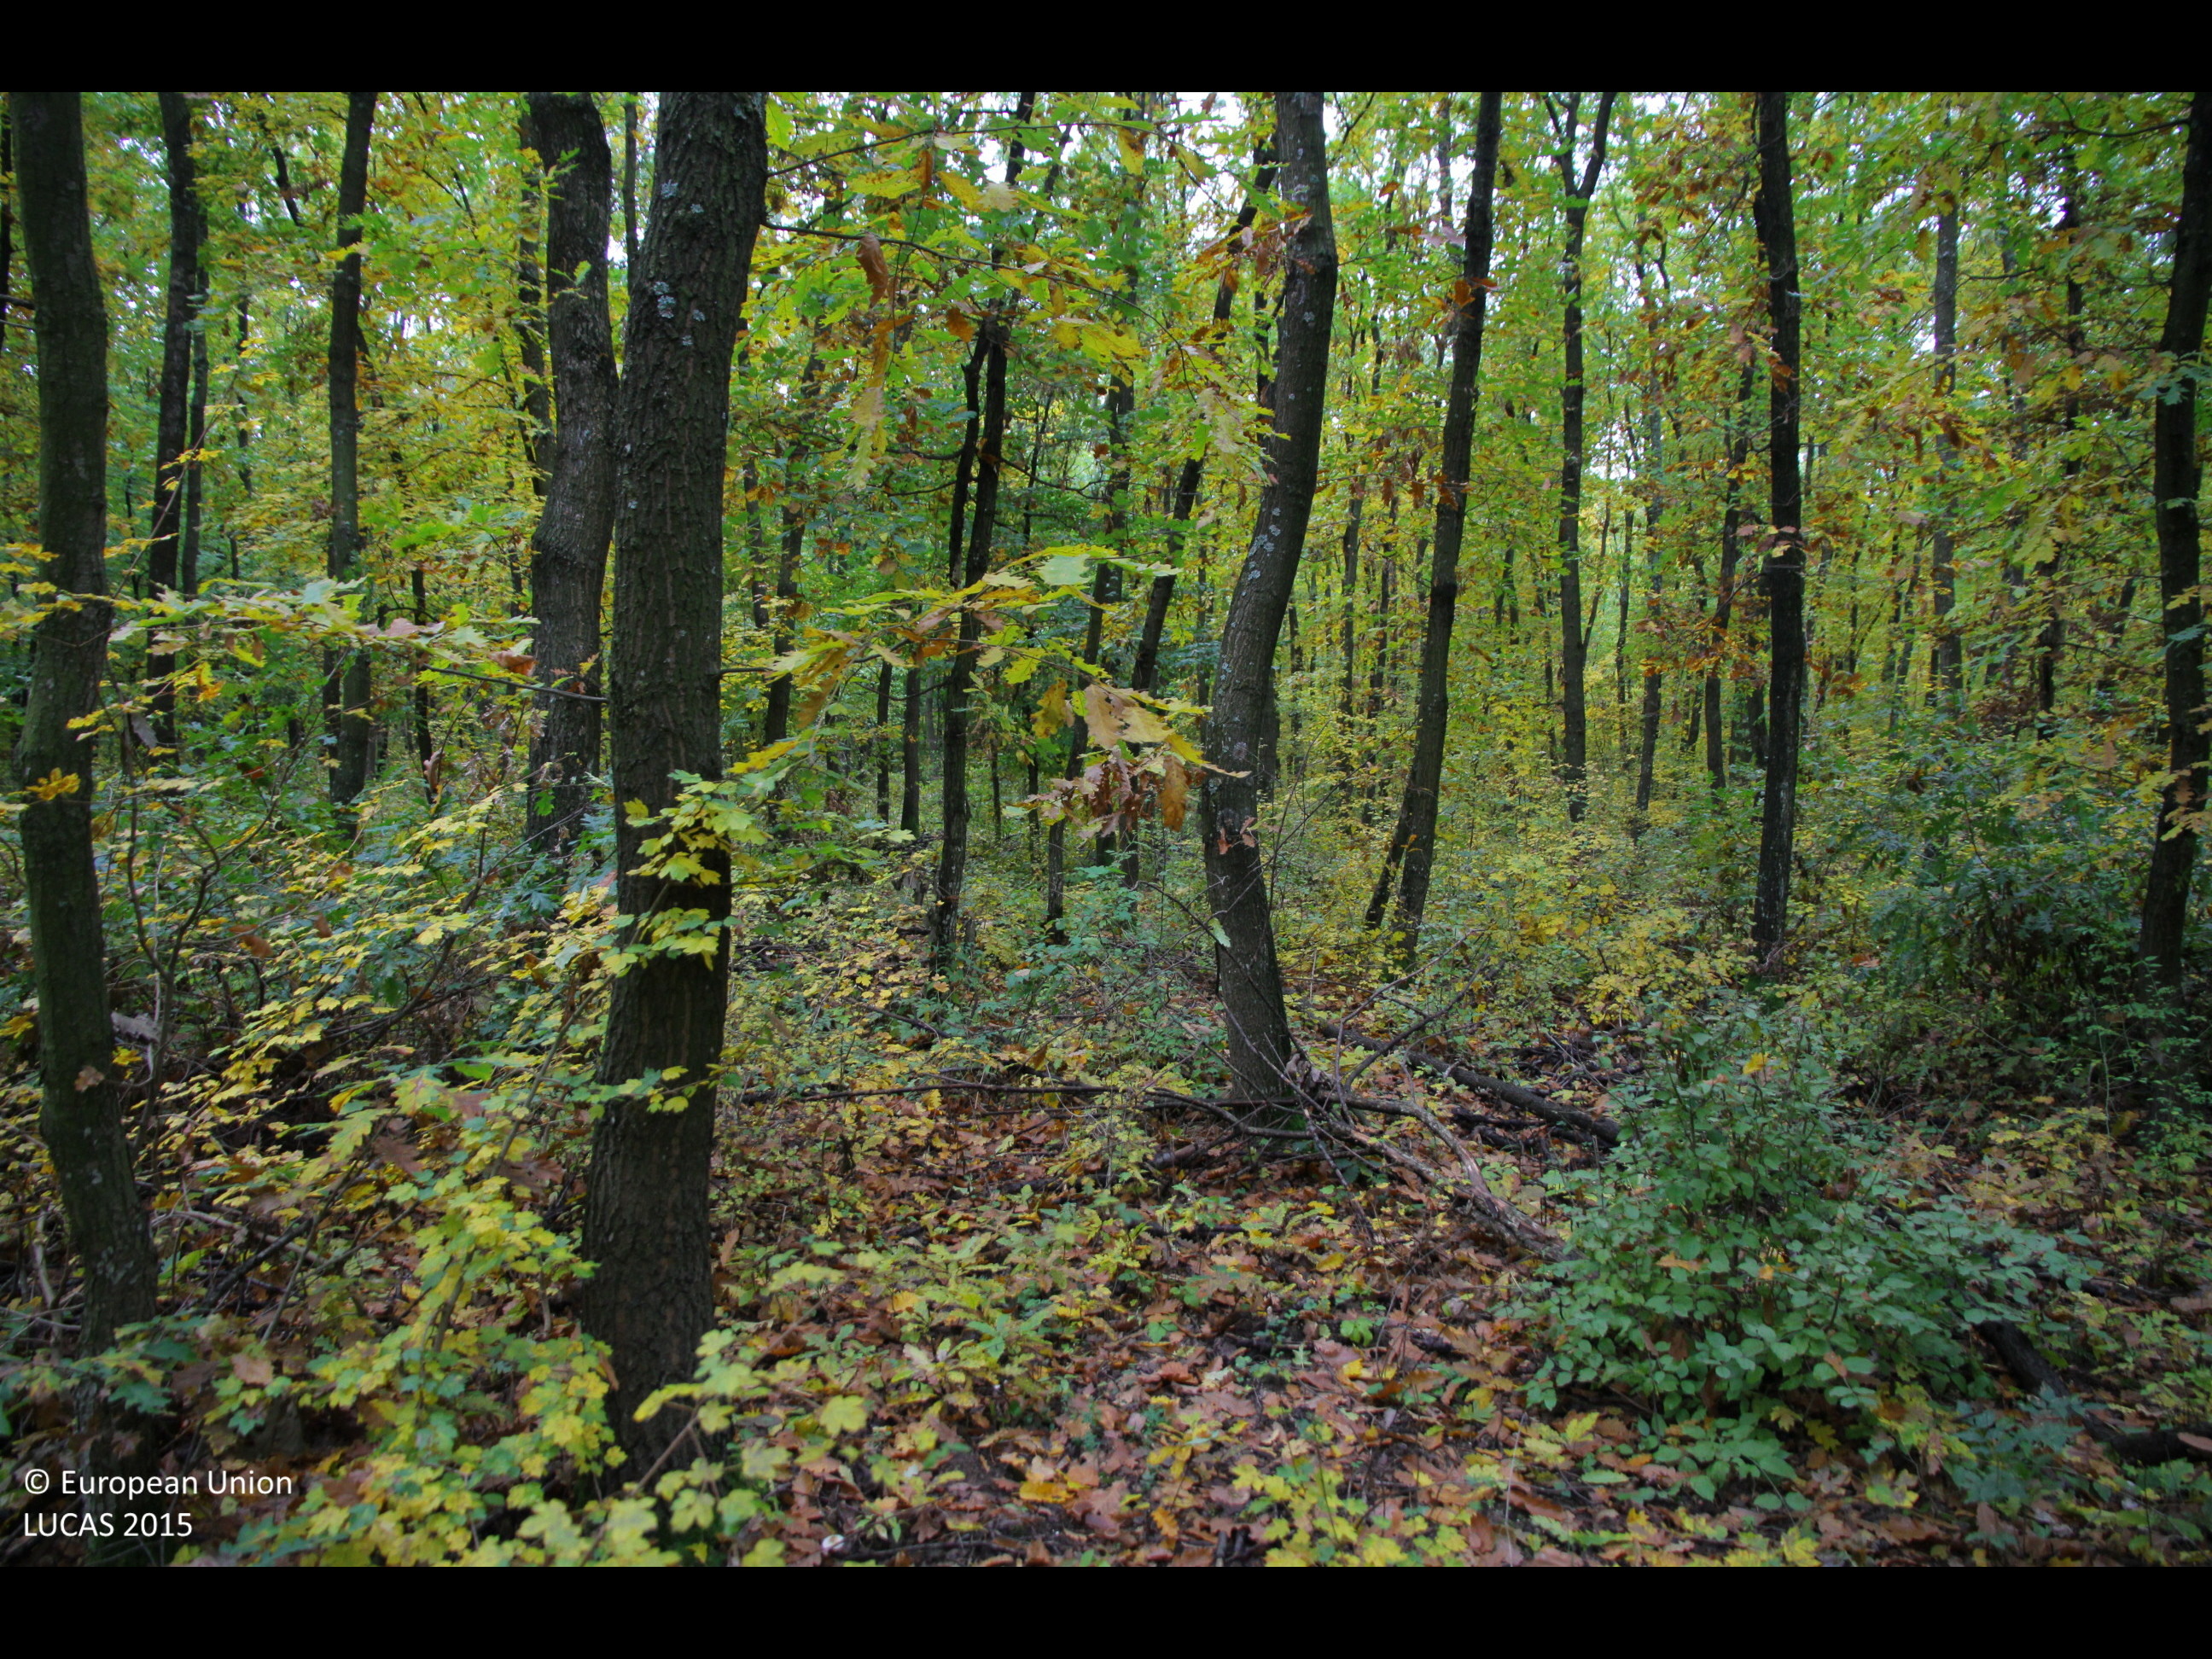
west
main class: Woodland
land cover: Broadleaved woodland
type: mesophytic deciduous forest
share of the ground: > 75 %
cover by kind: broadleaved forest trees 100 %
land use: Forestry
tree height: > 5 m
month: October
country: BG
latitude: 43.5299
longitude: 26.8554
